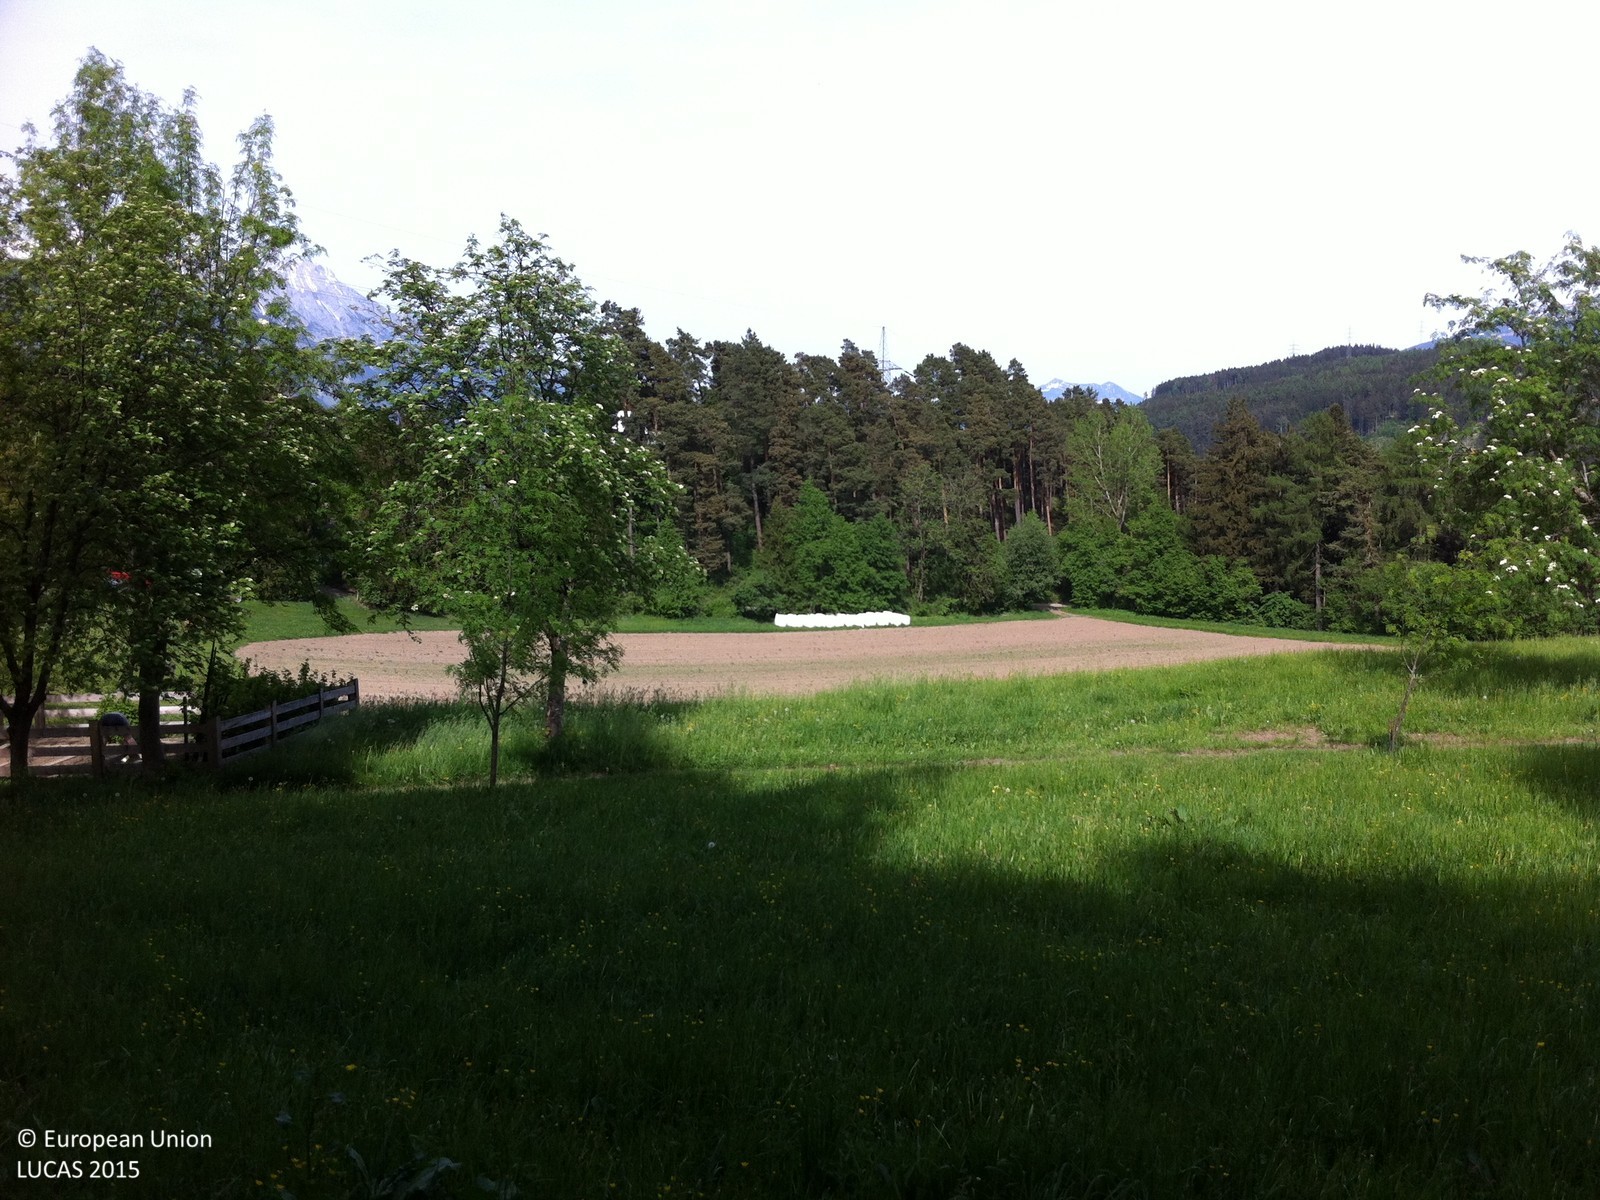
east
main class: Grassland
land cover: Grassland without tree/shrub cover
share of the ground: > 75 %
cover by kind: herbaceous plants 100 %
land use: Agriculture (excluding fallow land and kitchen gardens)
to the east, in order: Grassland without tree/shrub cover; Tracks; Lines of trees; Pear fruit; Maize; Grassland without tree/shrub cover; Broadleaved woodland; Electric lines; Tracks; Pine dominated coniferous woodland
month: May
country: AT
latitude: 47.2427
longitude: 11.3859
